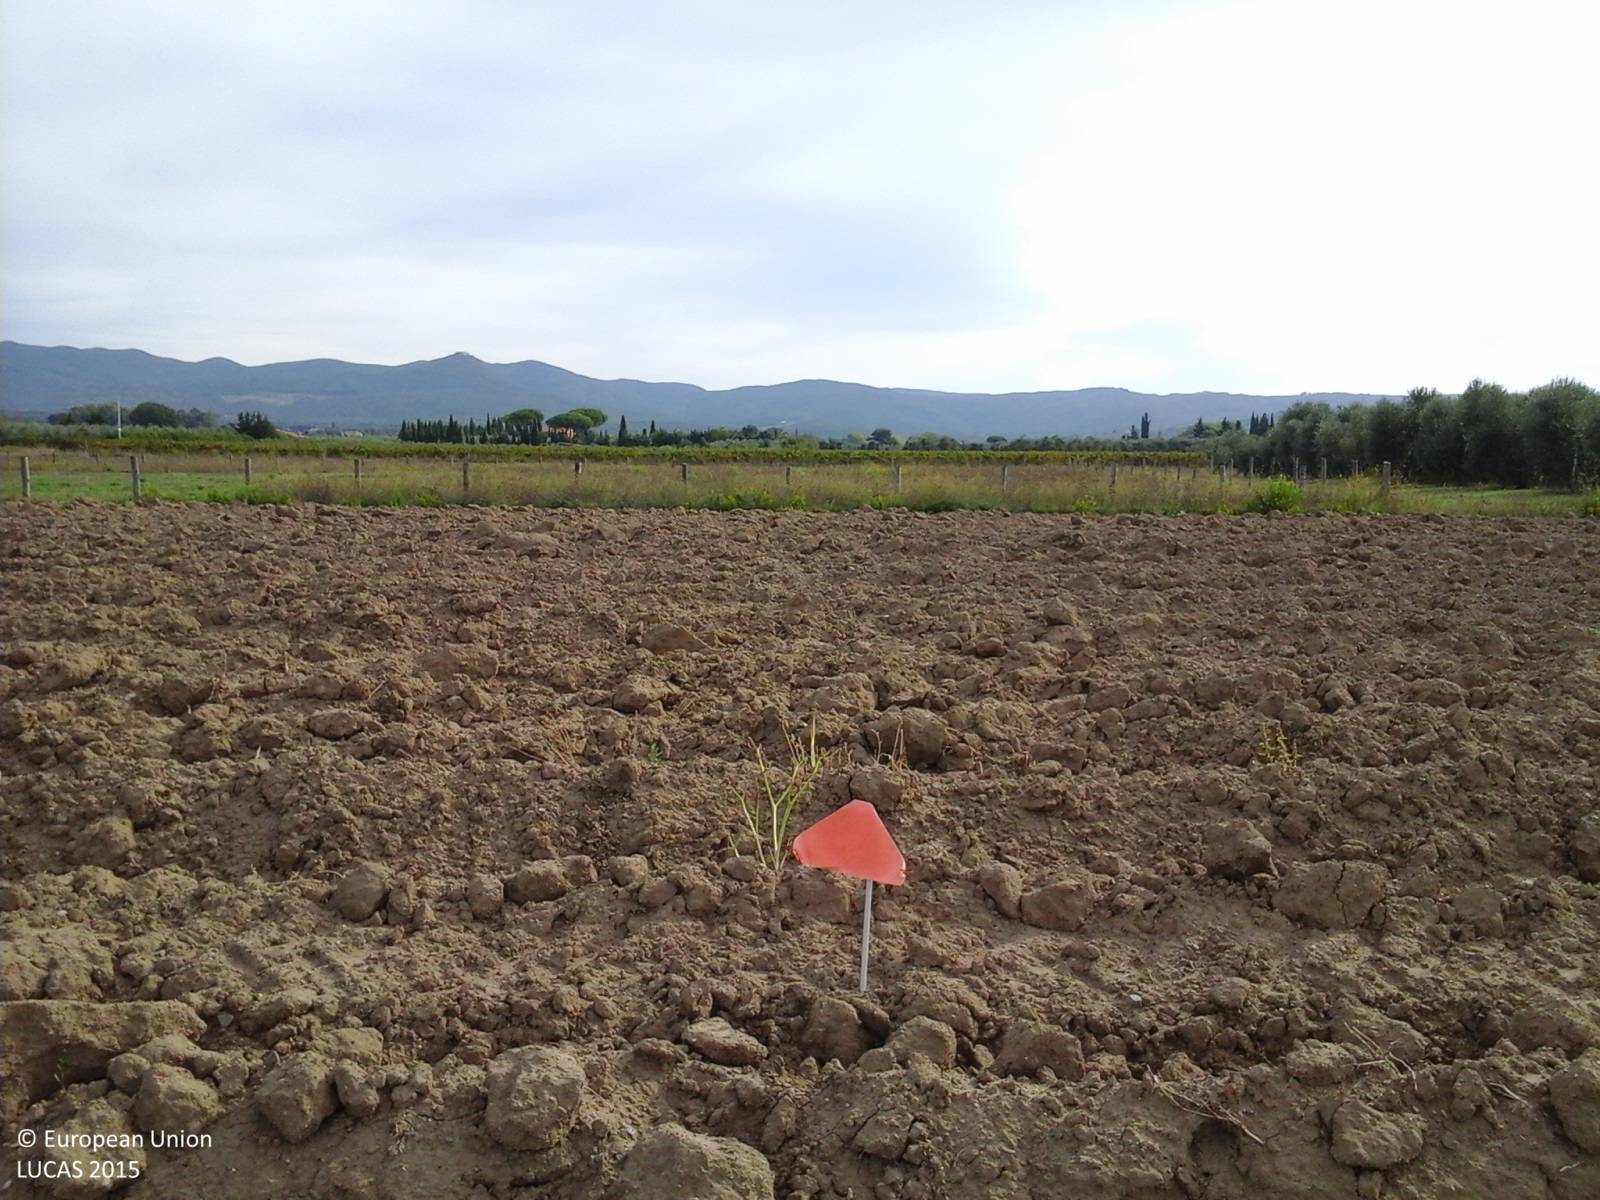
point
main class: Cropland
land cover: Tomatoes
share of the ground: < 10 %
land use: Agriculture (excluding fallow land and kitchen gardens)
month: October
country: IT
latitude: 43.1941
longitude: 10.5766
